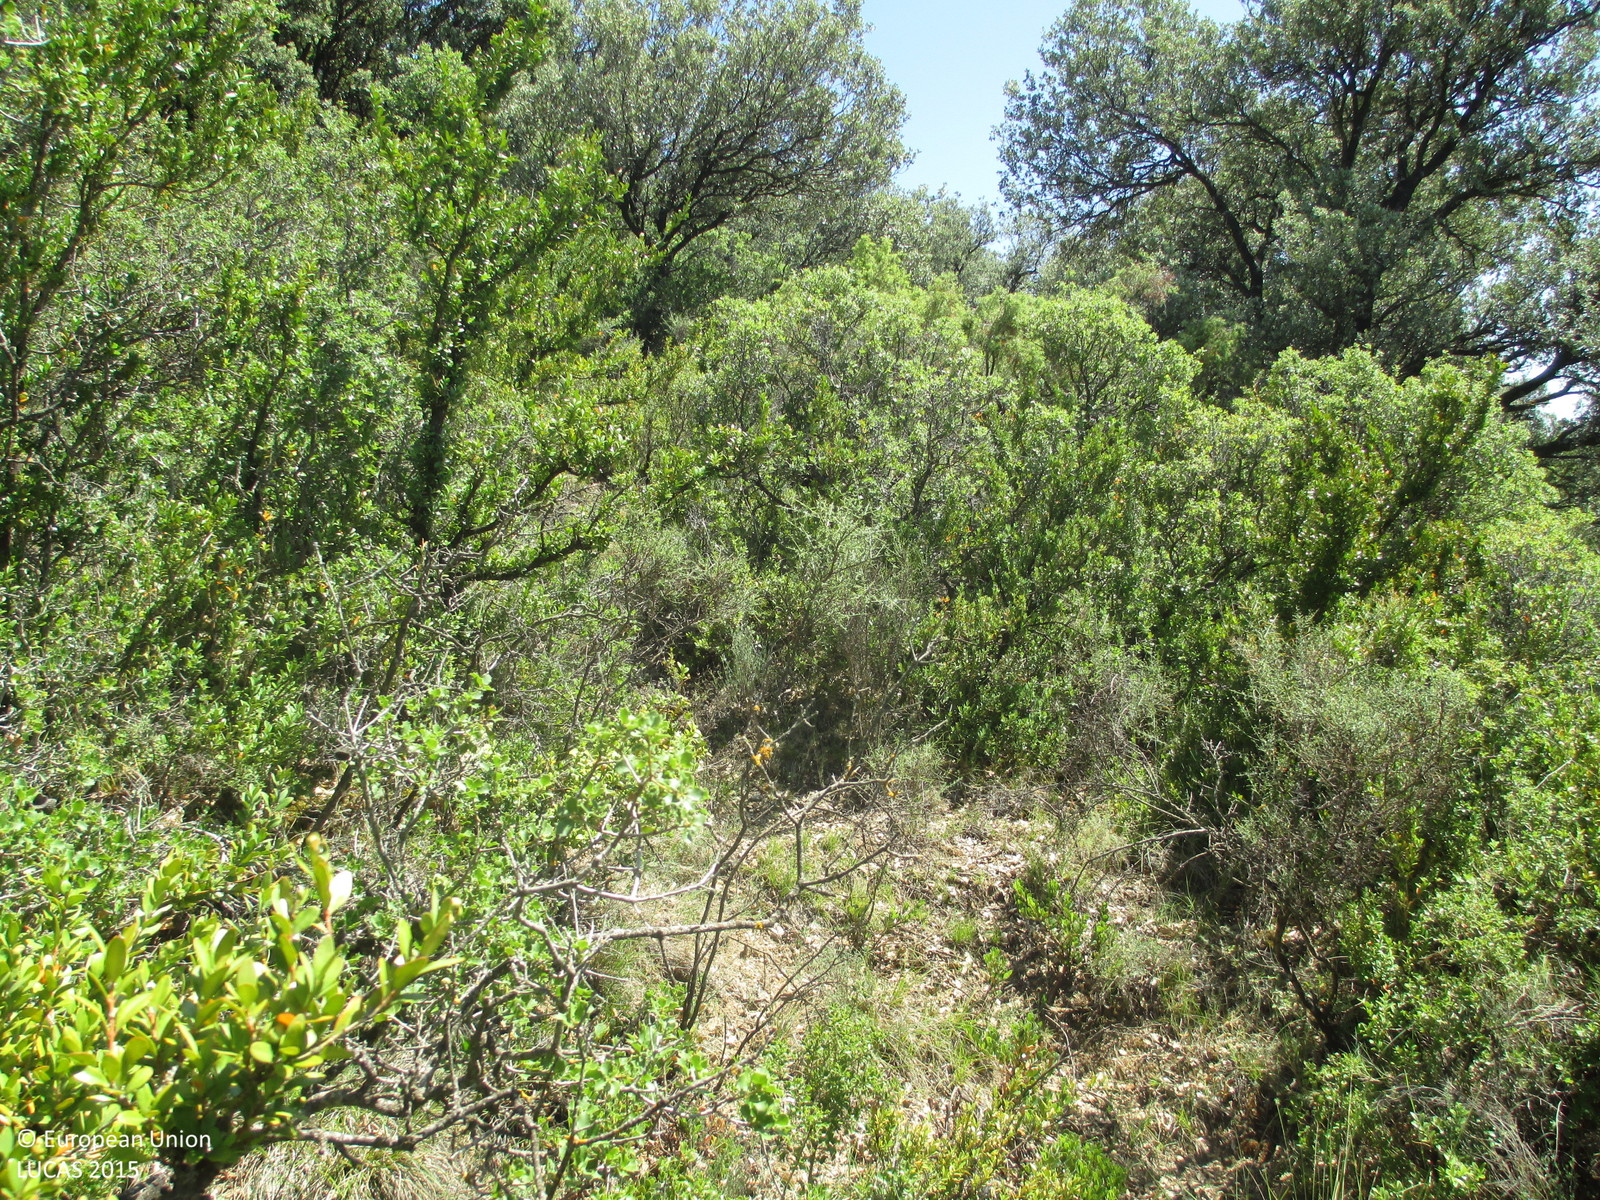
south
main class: Woodland
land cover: Broadleaved woodland
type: broadleaved evergreen forest
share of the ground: > 75 %
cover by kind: broadleaved forest trees 95 %, shrubs 5 %
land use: Semi-natural and natural areas not in use
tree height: < 5 m
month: June
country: ES
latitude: 42.1894
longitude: -0.2294
